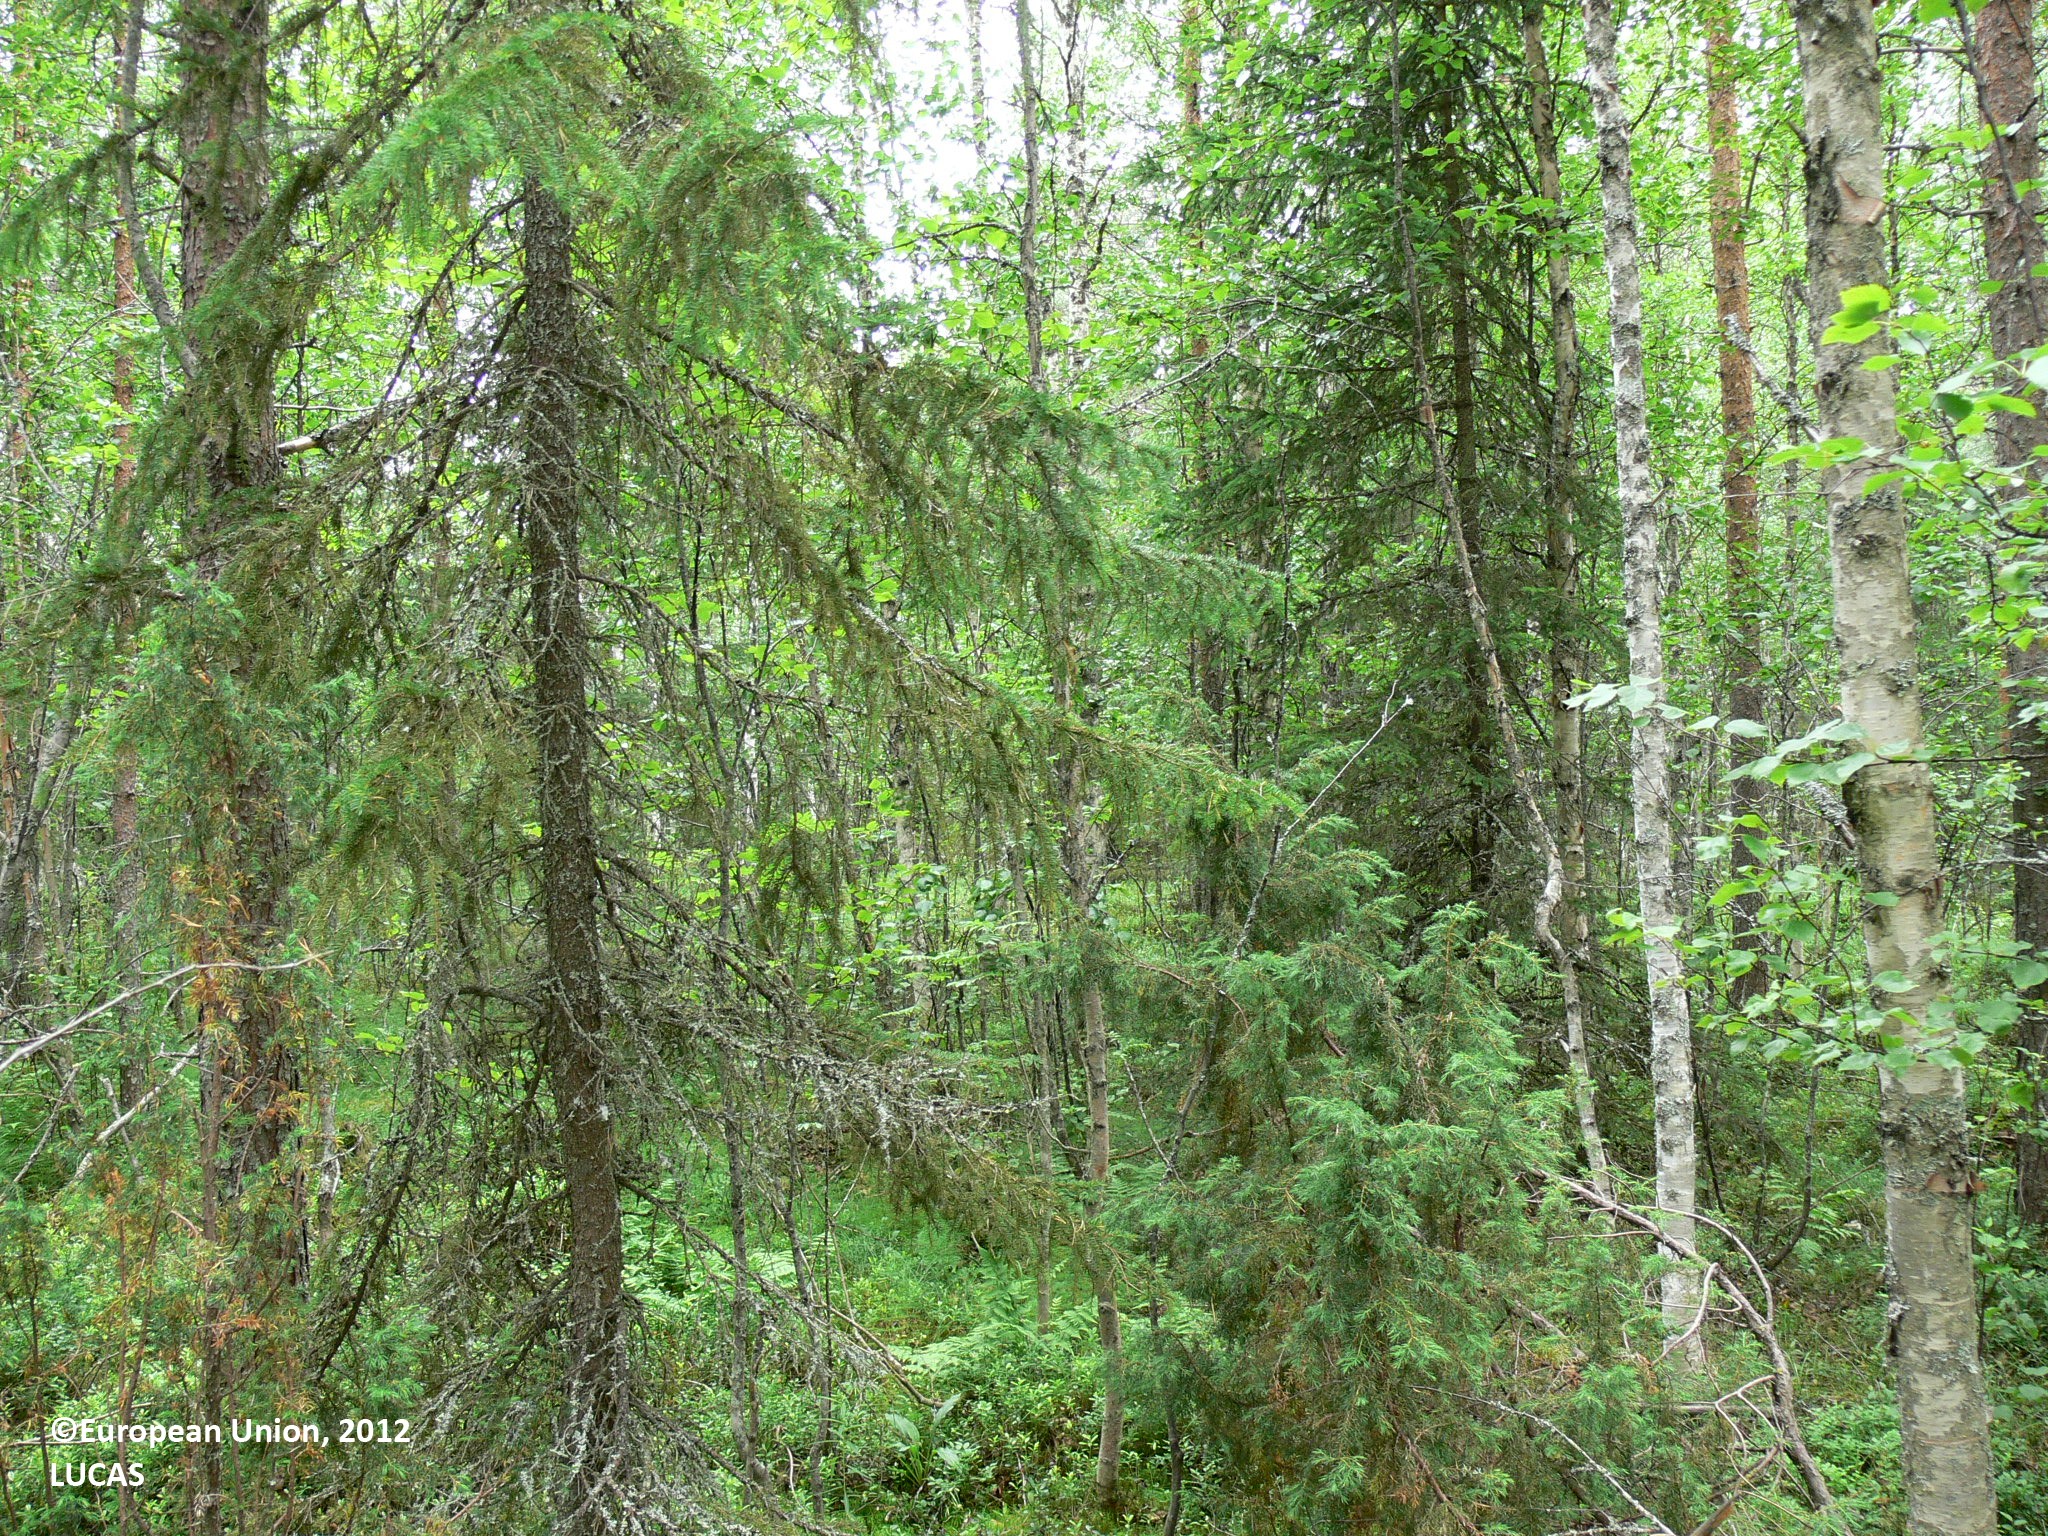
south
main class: Woodland
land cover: Other mixed woodland
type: boreal forest
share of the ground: > 75 %
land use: Forestry
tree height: > 5 m
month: July
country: FI
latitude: 63.2288
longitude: 30.7202
